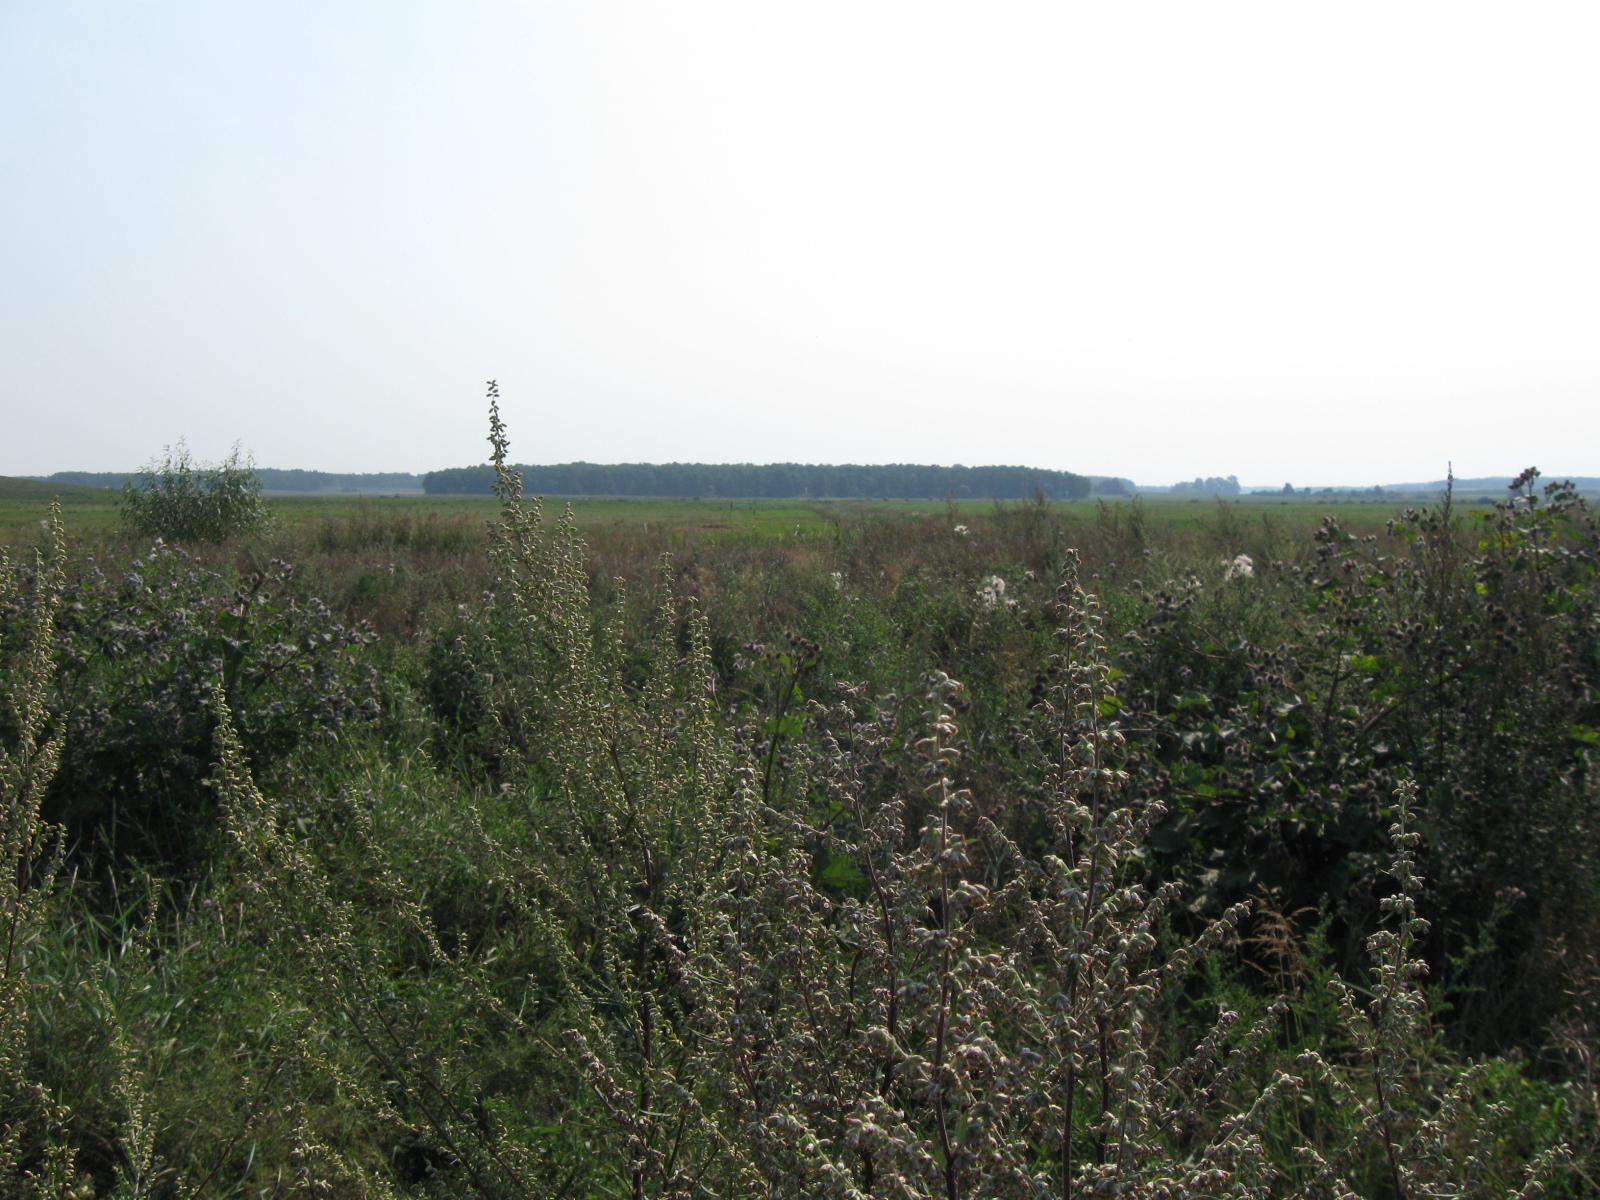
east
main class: Grassland
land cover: Spontaneously vegetated surfaces
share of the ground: > 75 %
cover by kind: herbaceous plants 100 %
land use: Fallow land
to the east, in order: Spontaneously vegetated surfaces; Ditches and canals; Spontaneously vegetated surfaces; Fences; Grassland without tree/shrub cover; Fences; Grassland without tree/shrub cover; Fences; Grassland without tree/shrub cover
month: August
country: LT
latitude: 54.3493
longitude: 23.2311
